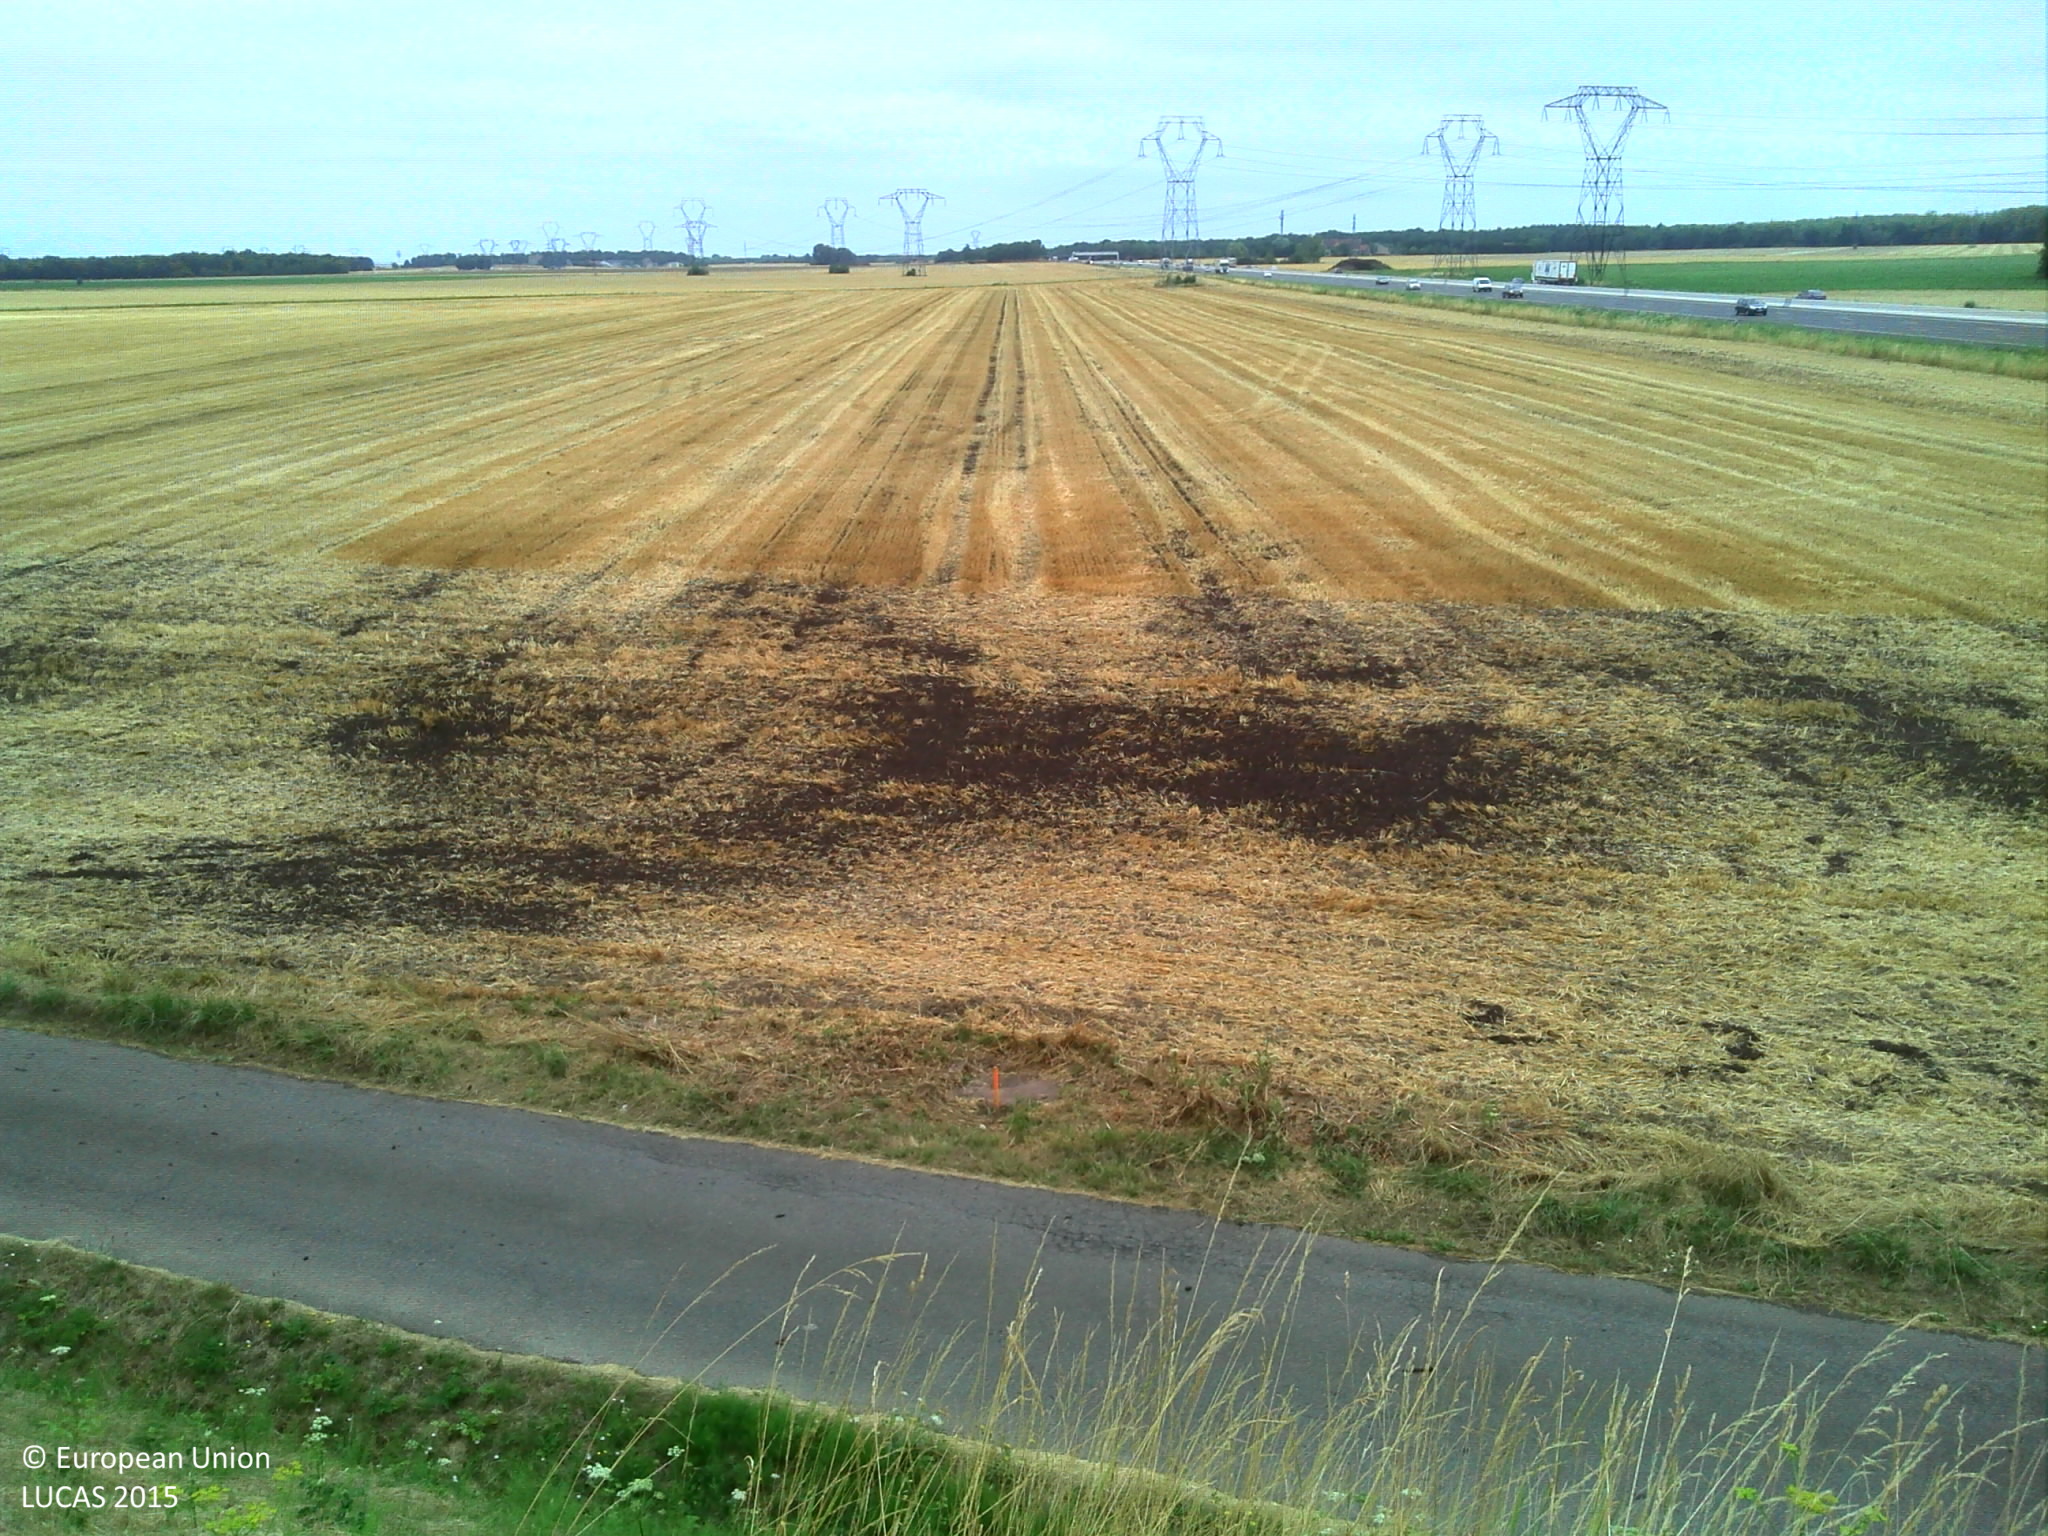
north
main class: Grassland
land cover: Grassland without tree/shrub cover
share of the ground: > 75 %
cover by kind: herbaceous plants 70 %, consolidated bare surface 10 %, unconsolidated bare surface 10 %, shrubs 5 %, lichens and mosses 5 %
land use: Road transport
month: July
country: FR
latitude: 48.5281
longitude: 2.5010
